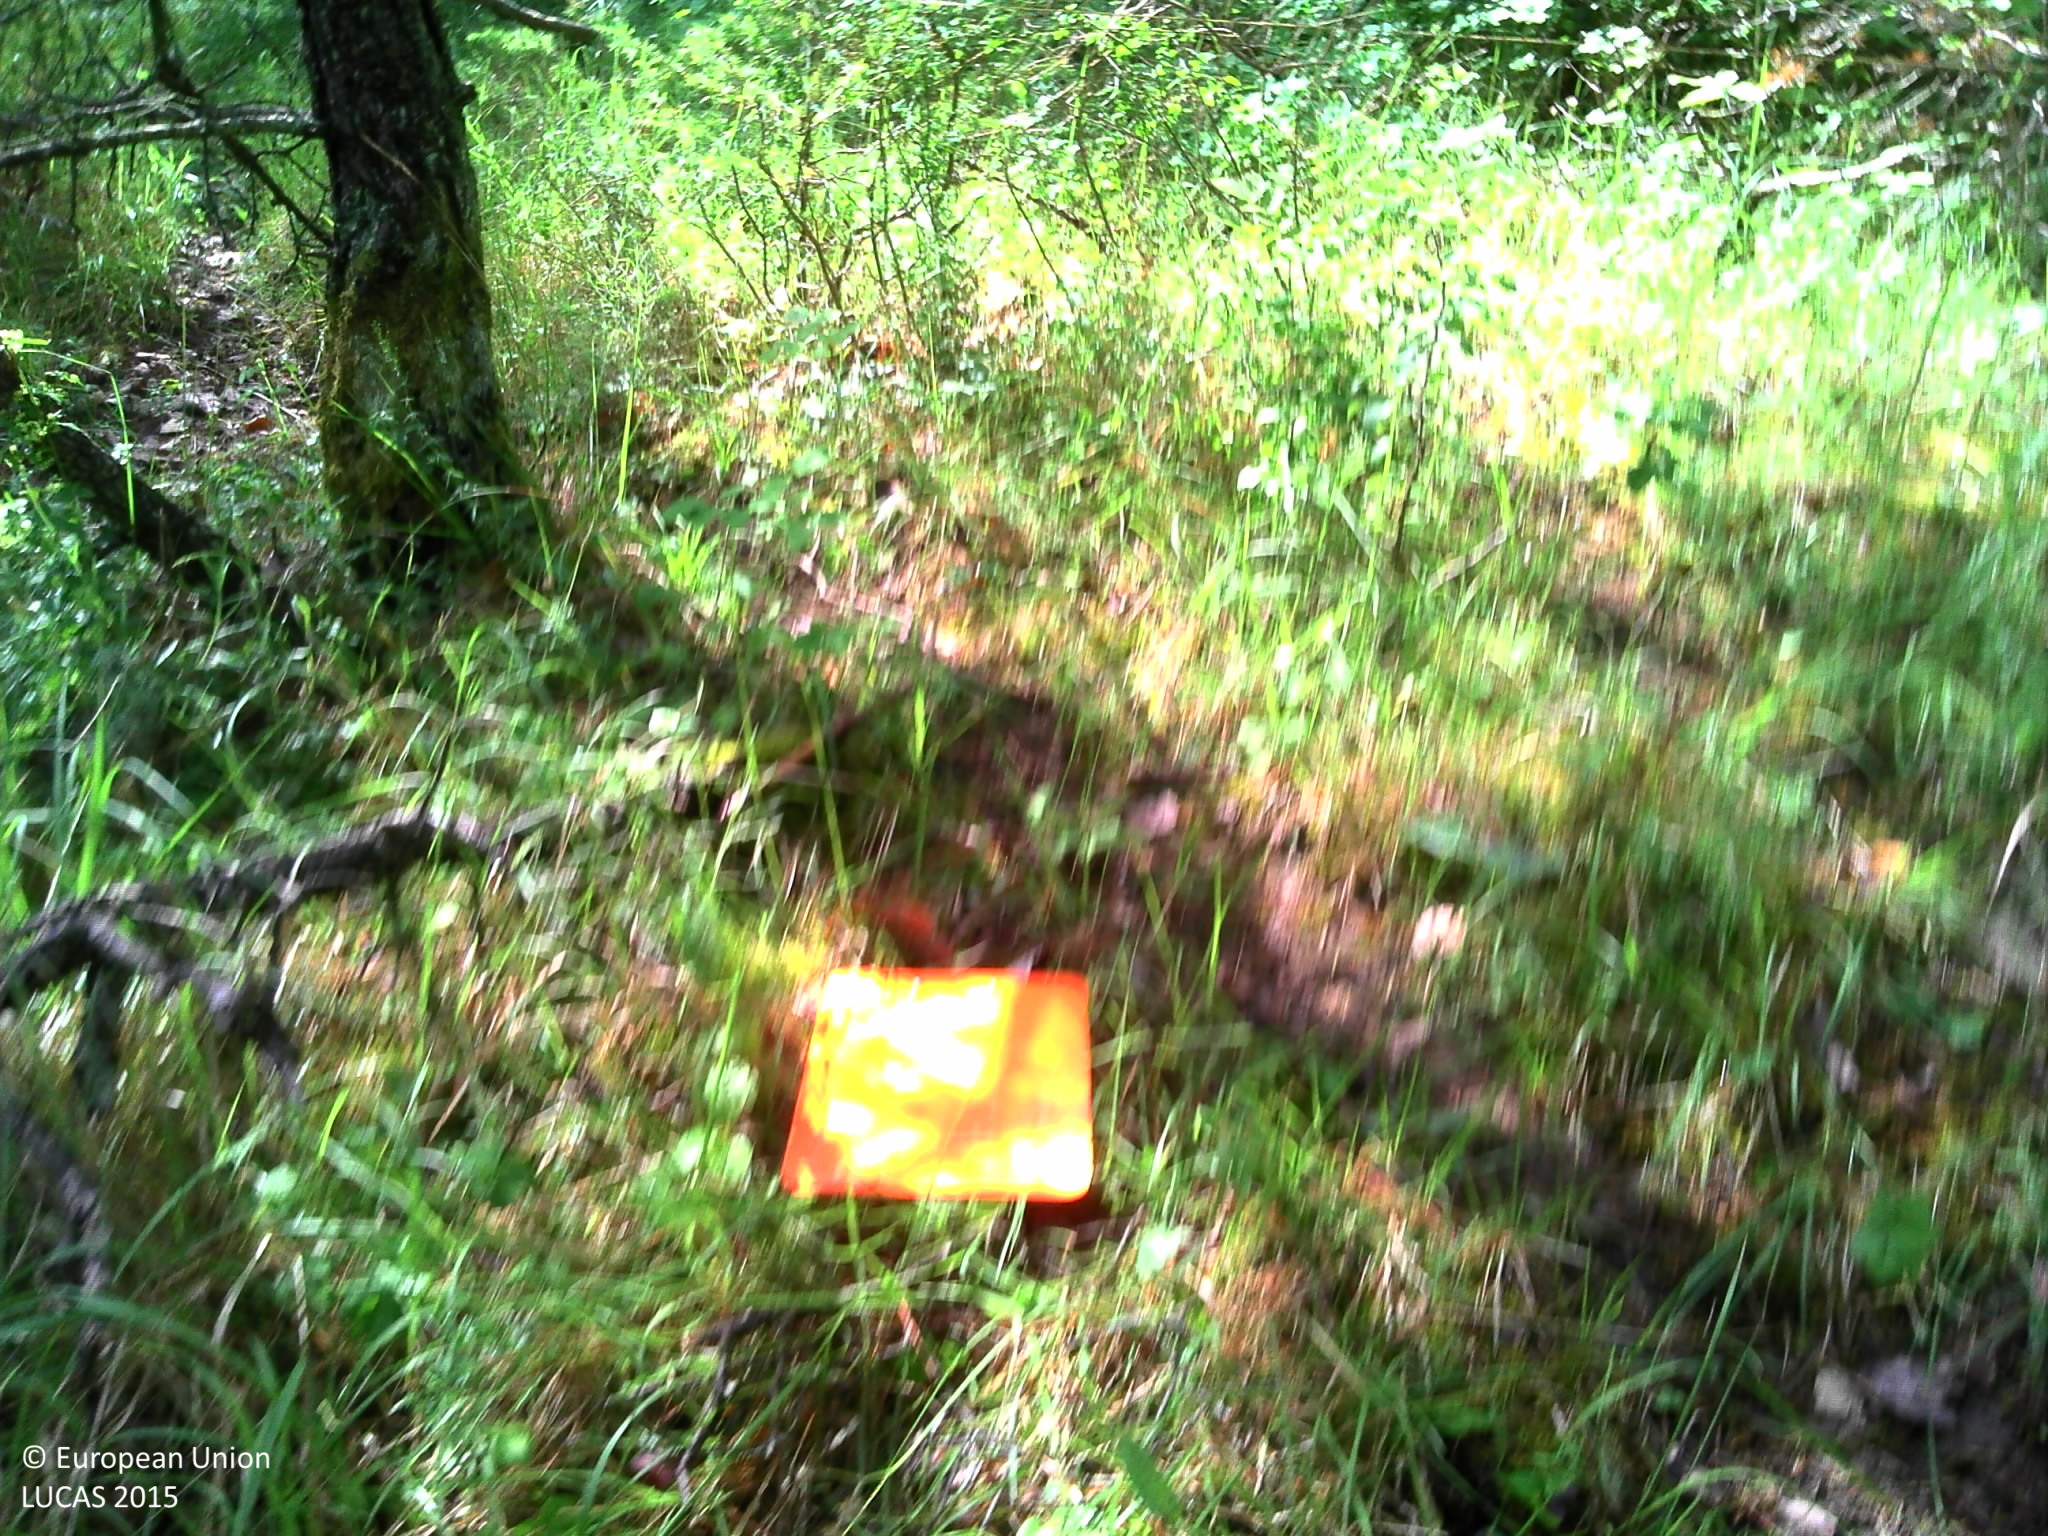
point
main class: Woodland
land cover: Pine dominated mixed woodland
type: coniferous forest of the mediterranean region
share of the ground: > 75 %
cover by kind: coniferous forest trees 70 %, broadleaved forest trees 25 %, herbaceous plants 5 %
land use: Forestry
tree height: > 5 m
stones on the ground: 10 - 25 %
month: June
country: FR
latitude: 44.6742
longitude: 5.2256
